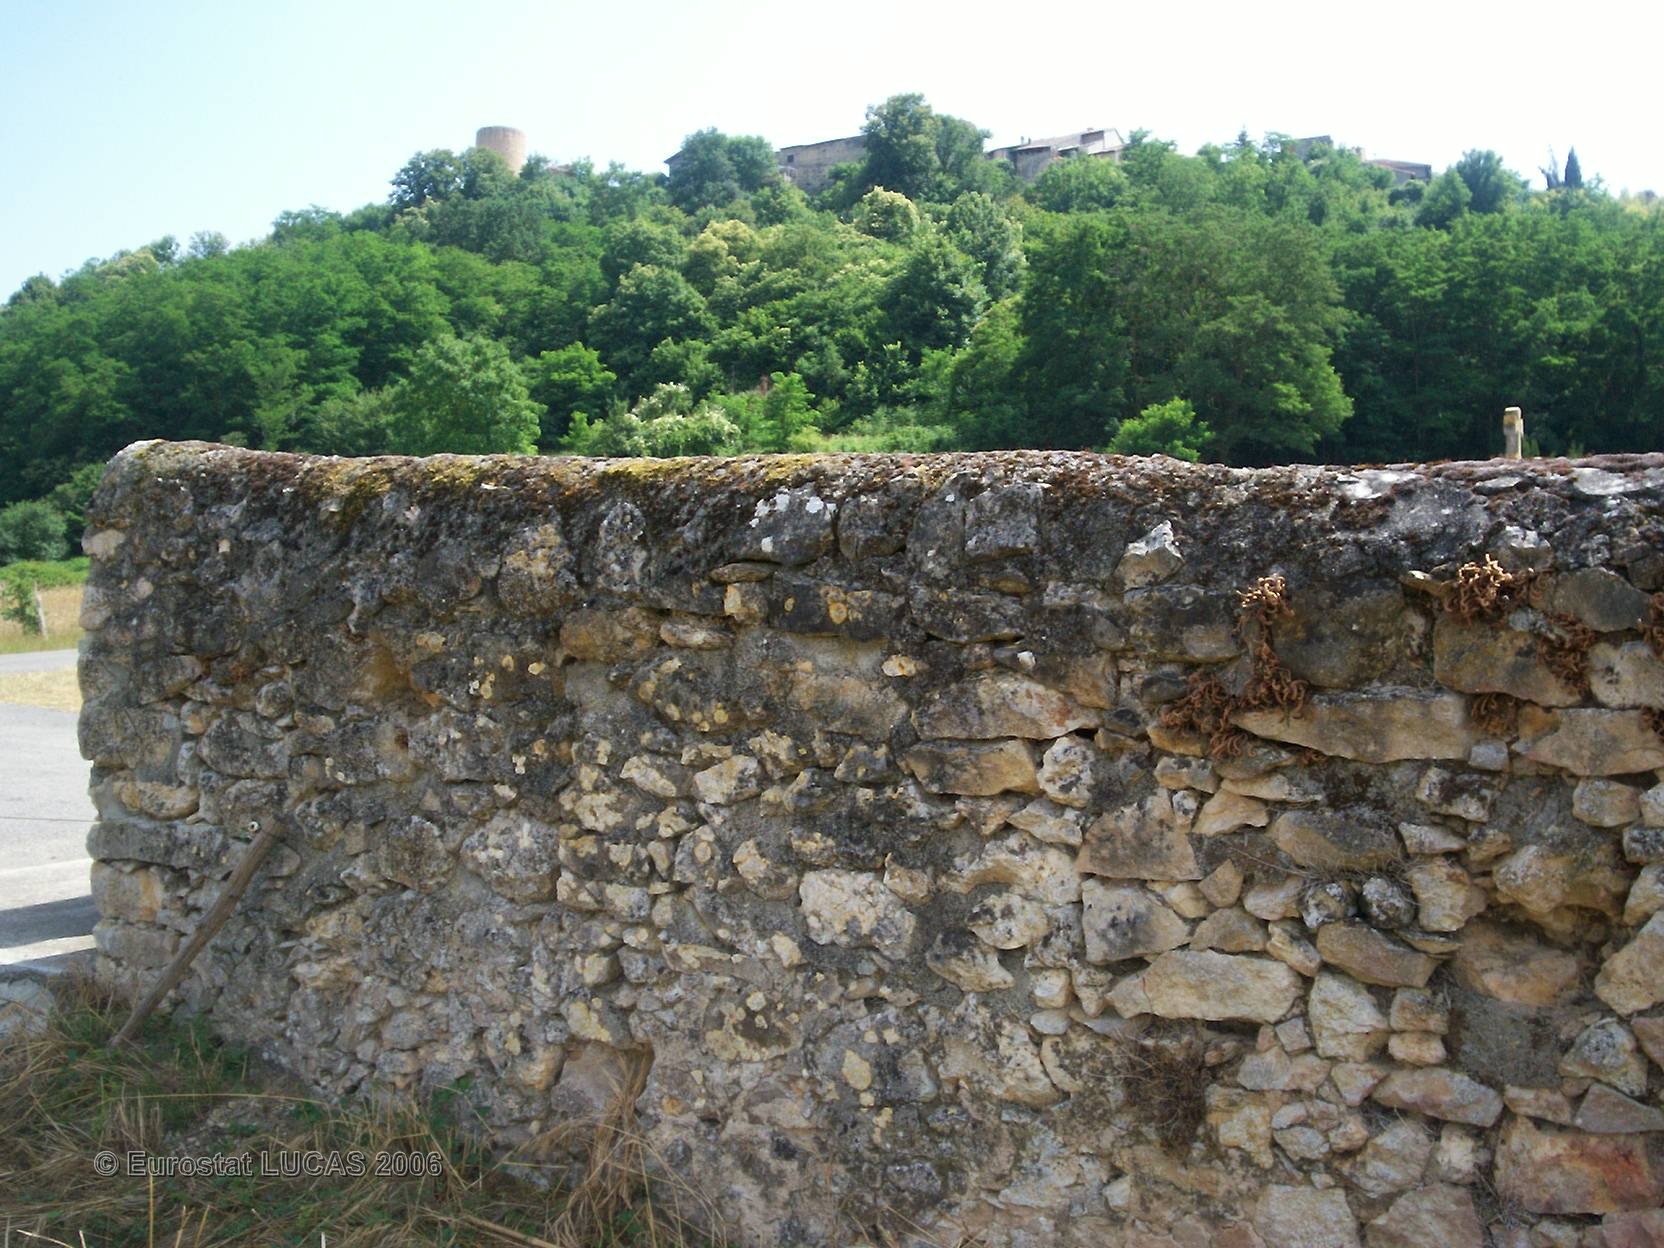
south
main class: Grassland
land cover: Grassland without tree/shrub cover
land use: Agriculture (excluding fallow land and kitchen gardens)
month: June
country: FR
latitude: 43.2223
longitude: 0.8794
